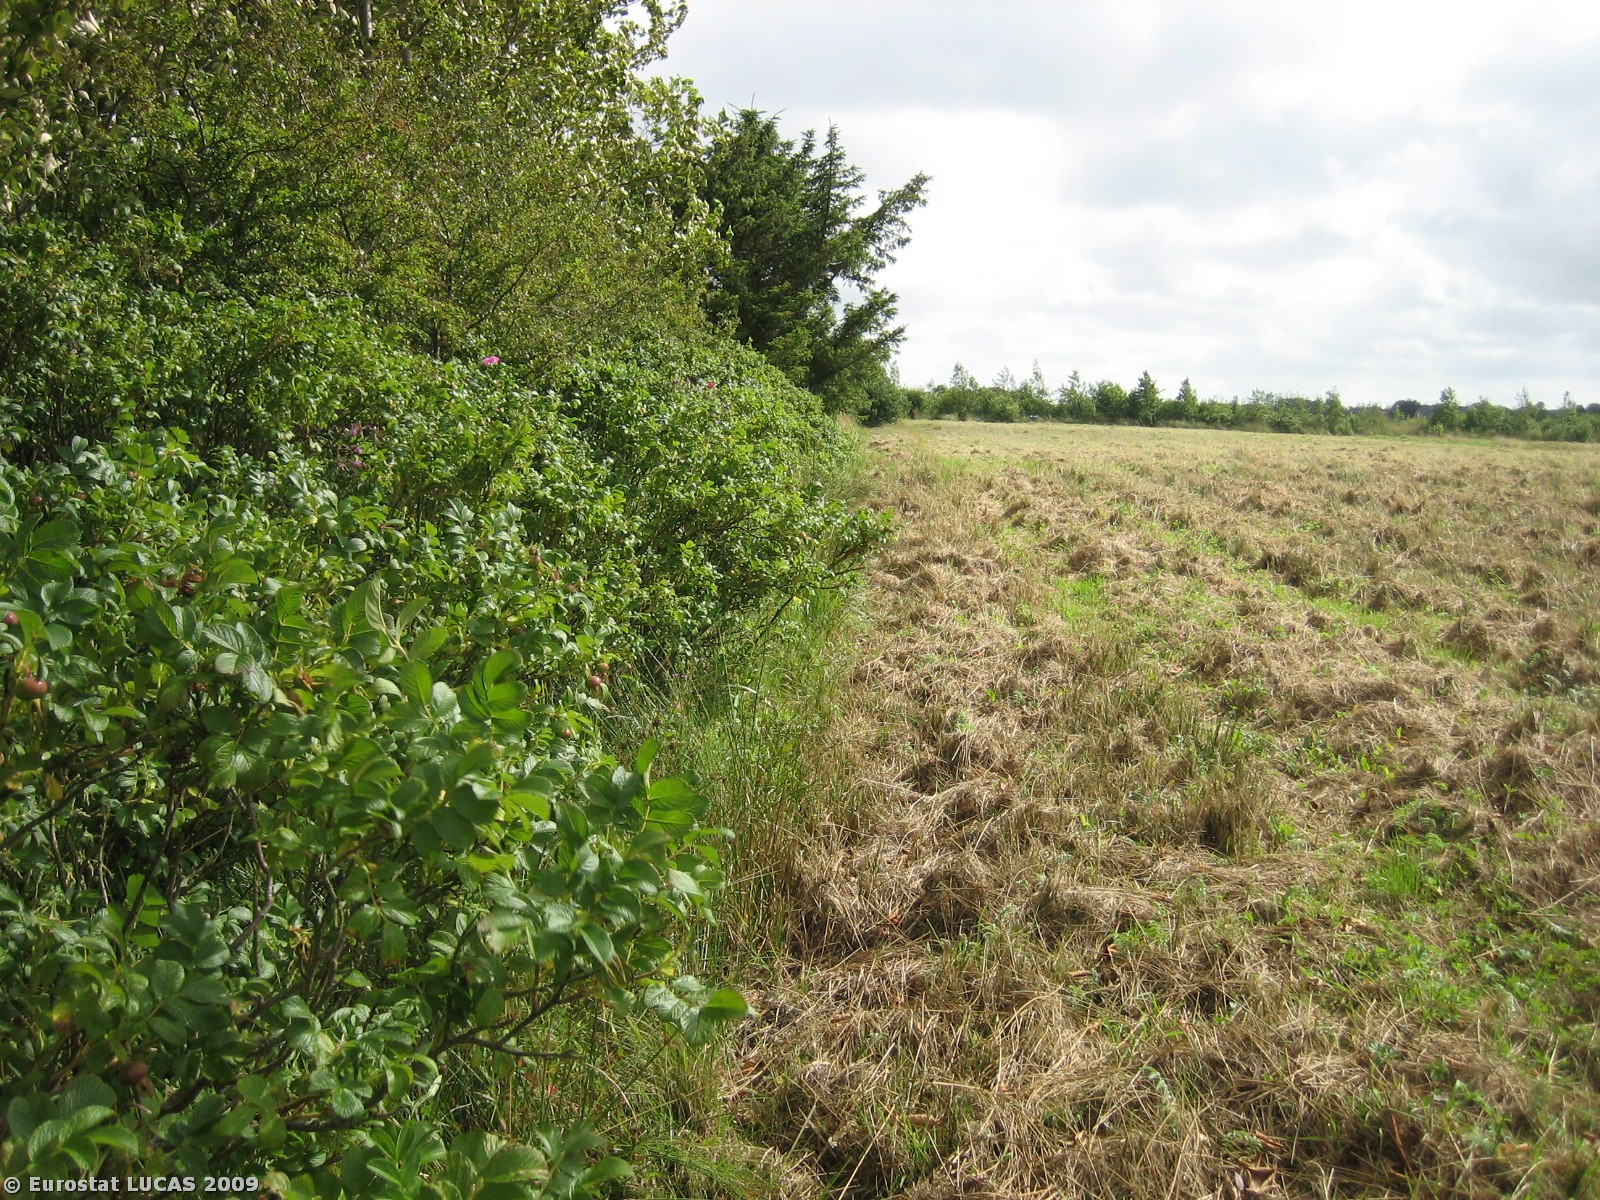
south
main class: Grassland
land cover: Grassland without tree/shrub cover
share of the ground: > 75 %
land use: Agriculture (excluding fallow land and kitchen gardens)
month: July
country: DK
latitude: 55.6551
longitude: 8.3010
